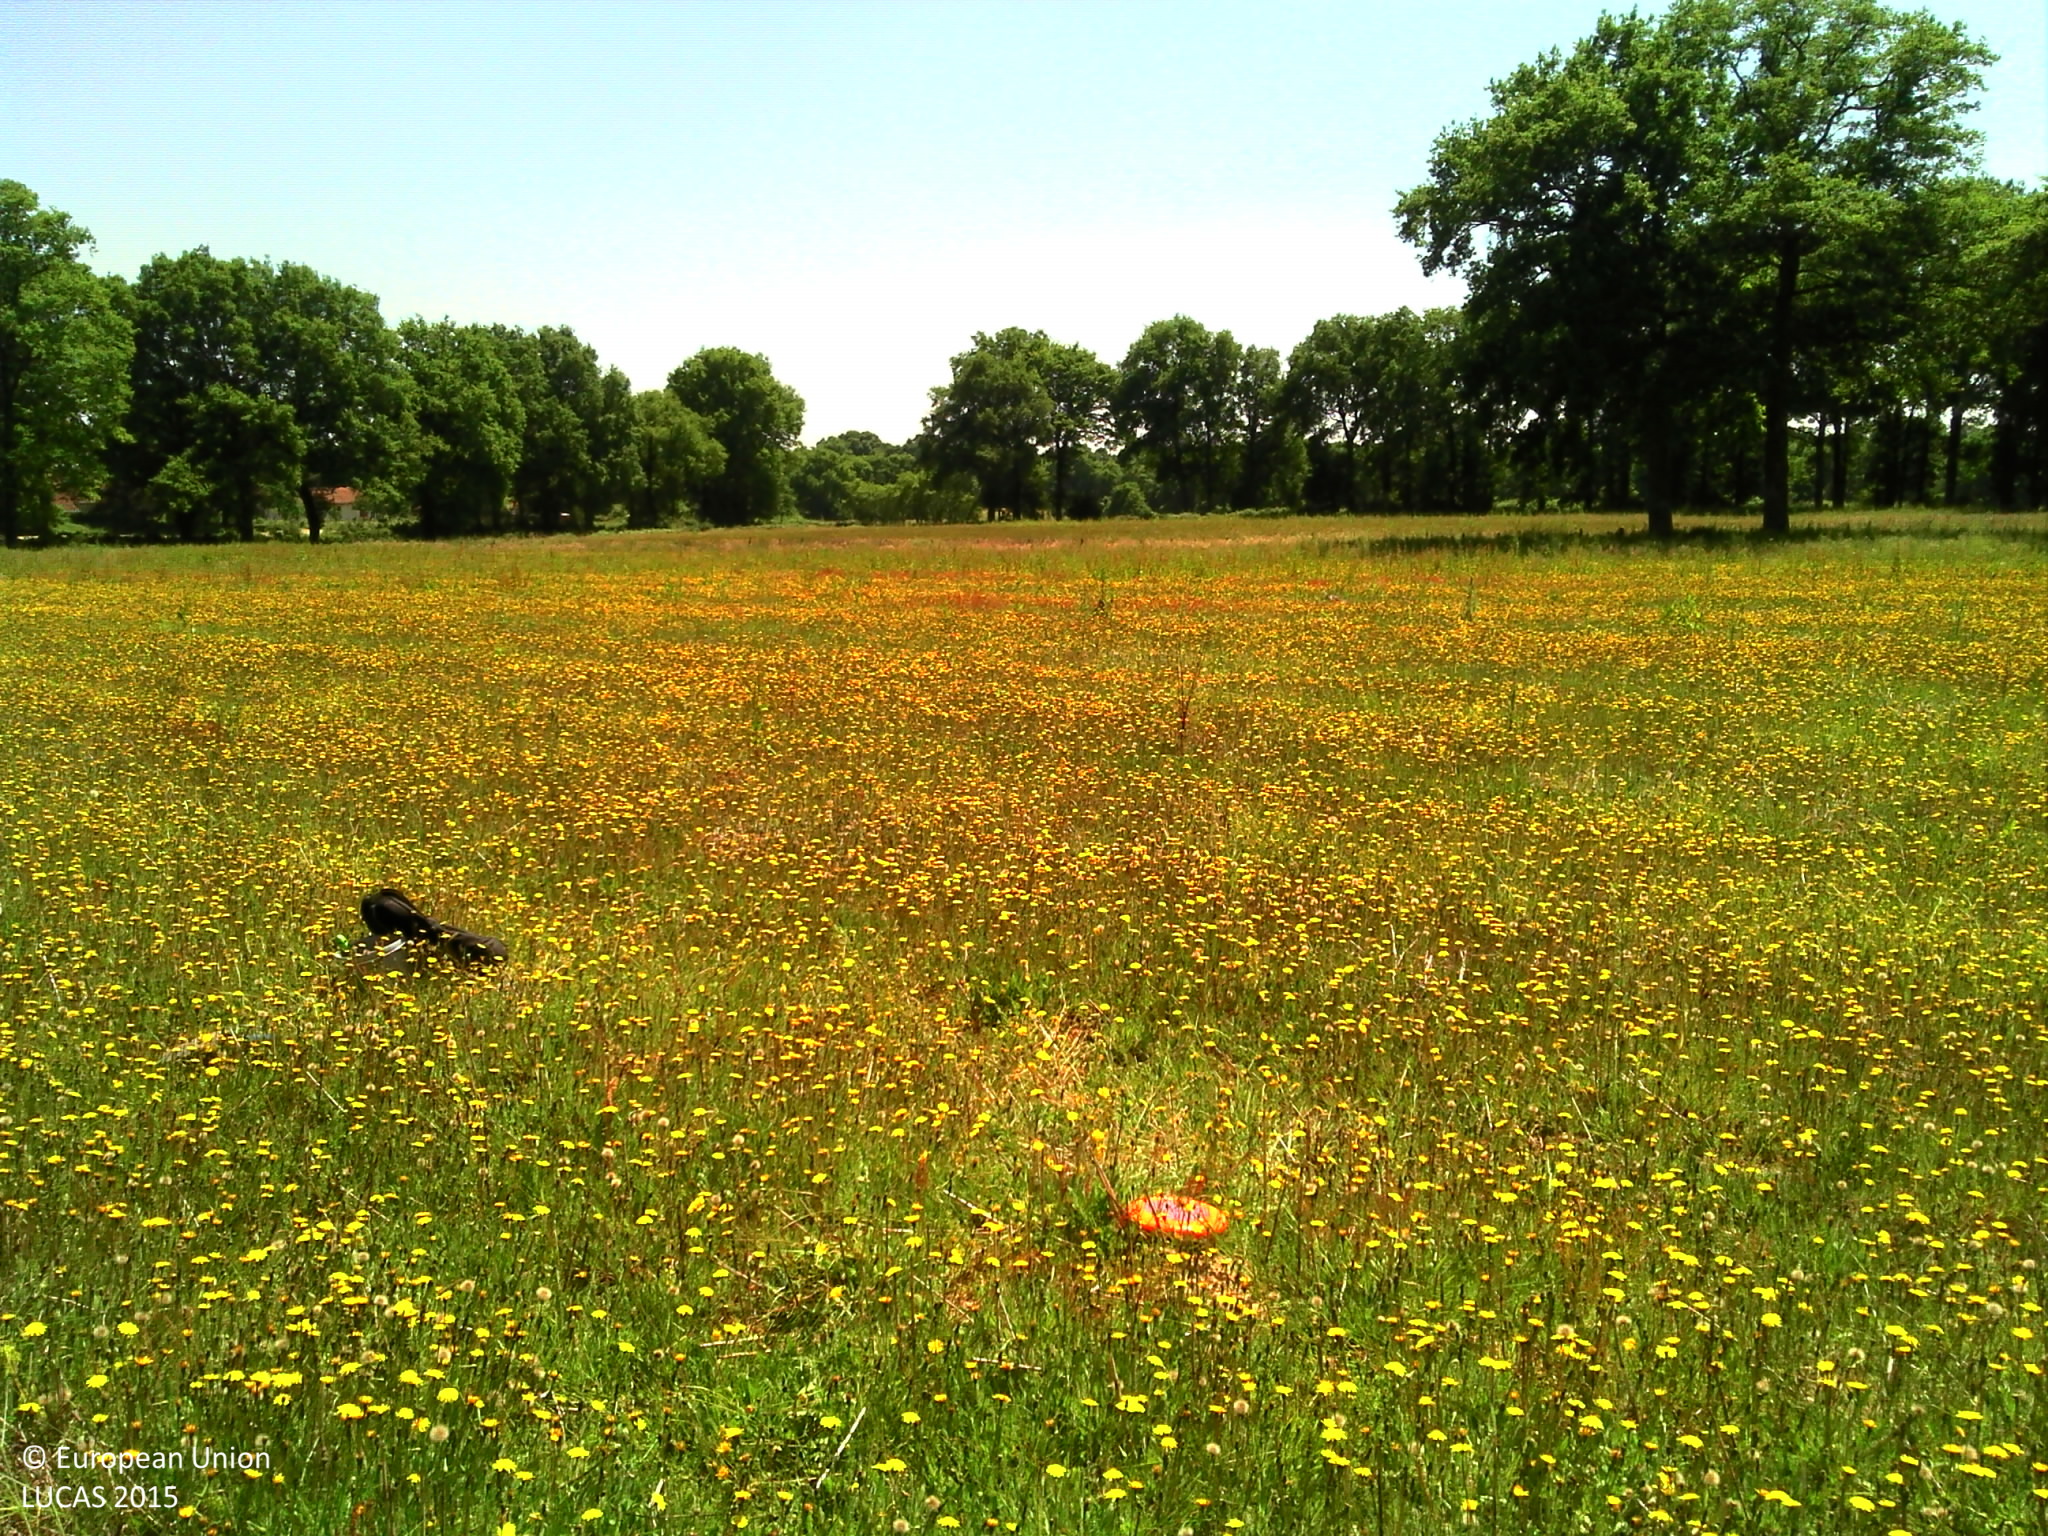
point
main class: Grassland
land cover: Spontaneously vegetated surfaces
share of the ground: > 75 %
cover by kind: herbaceous plants 100 %
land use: Agriculture (excluding fallow land and kitchen gardens)
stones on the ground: < 10 %
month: June
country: FR
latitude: 46.1315
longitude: 0.7577
